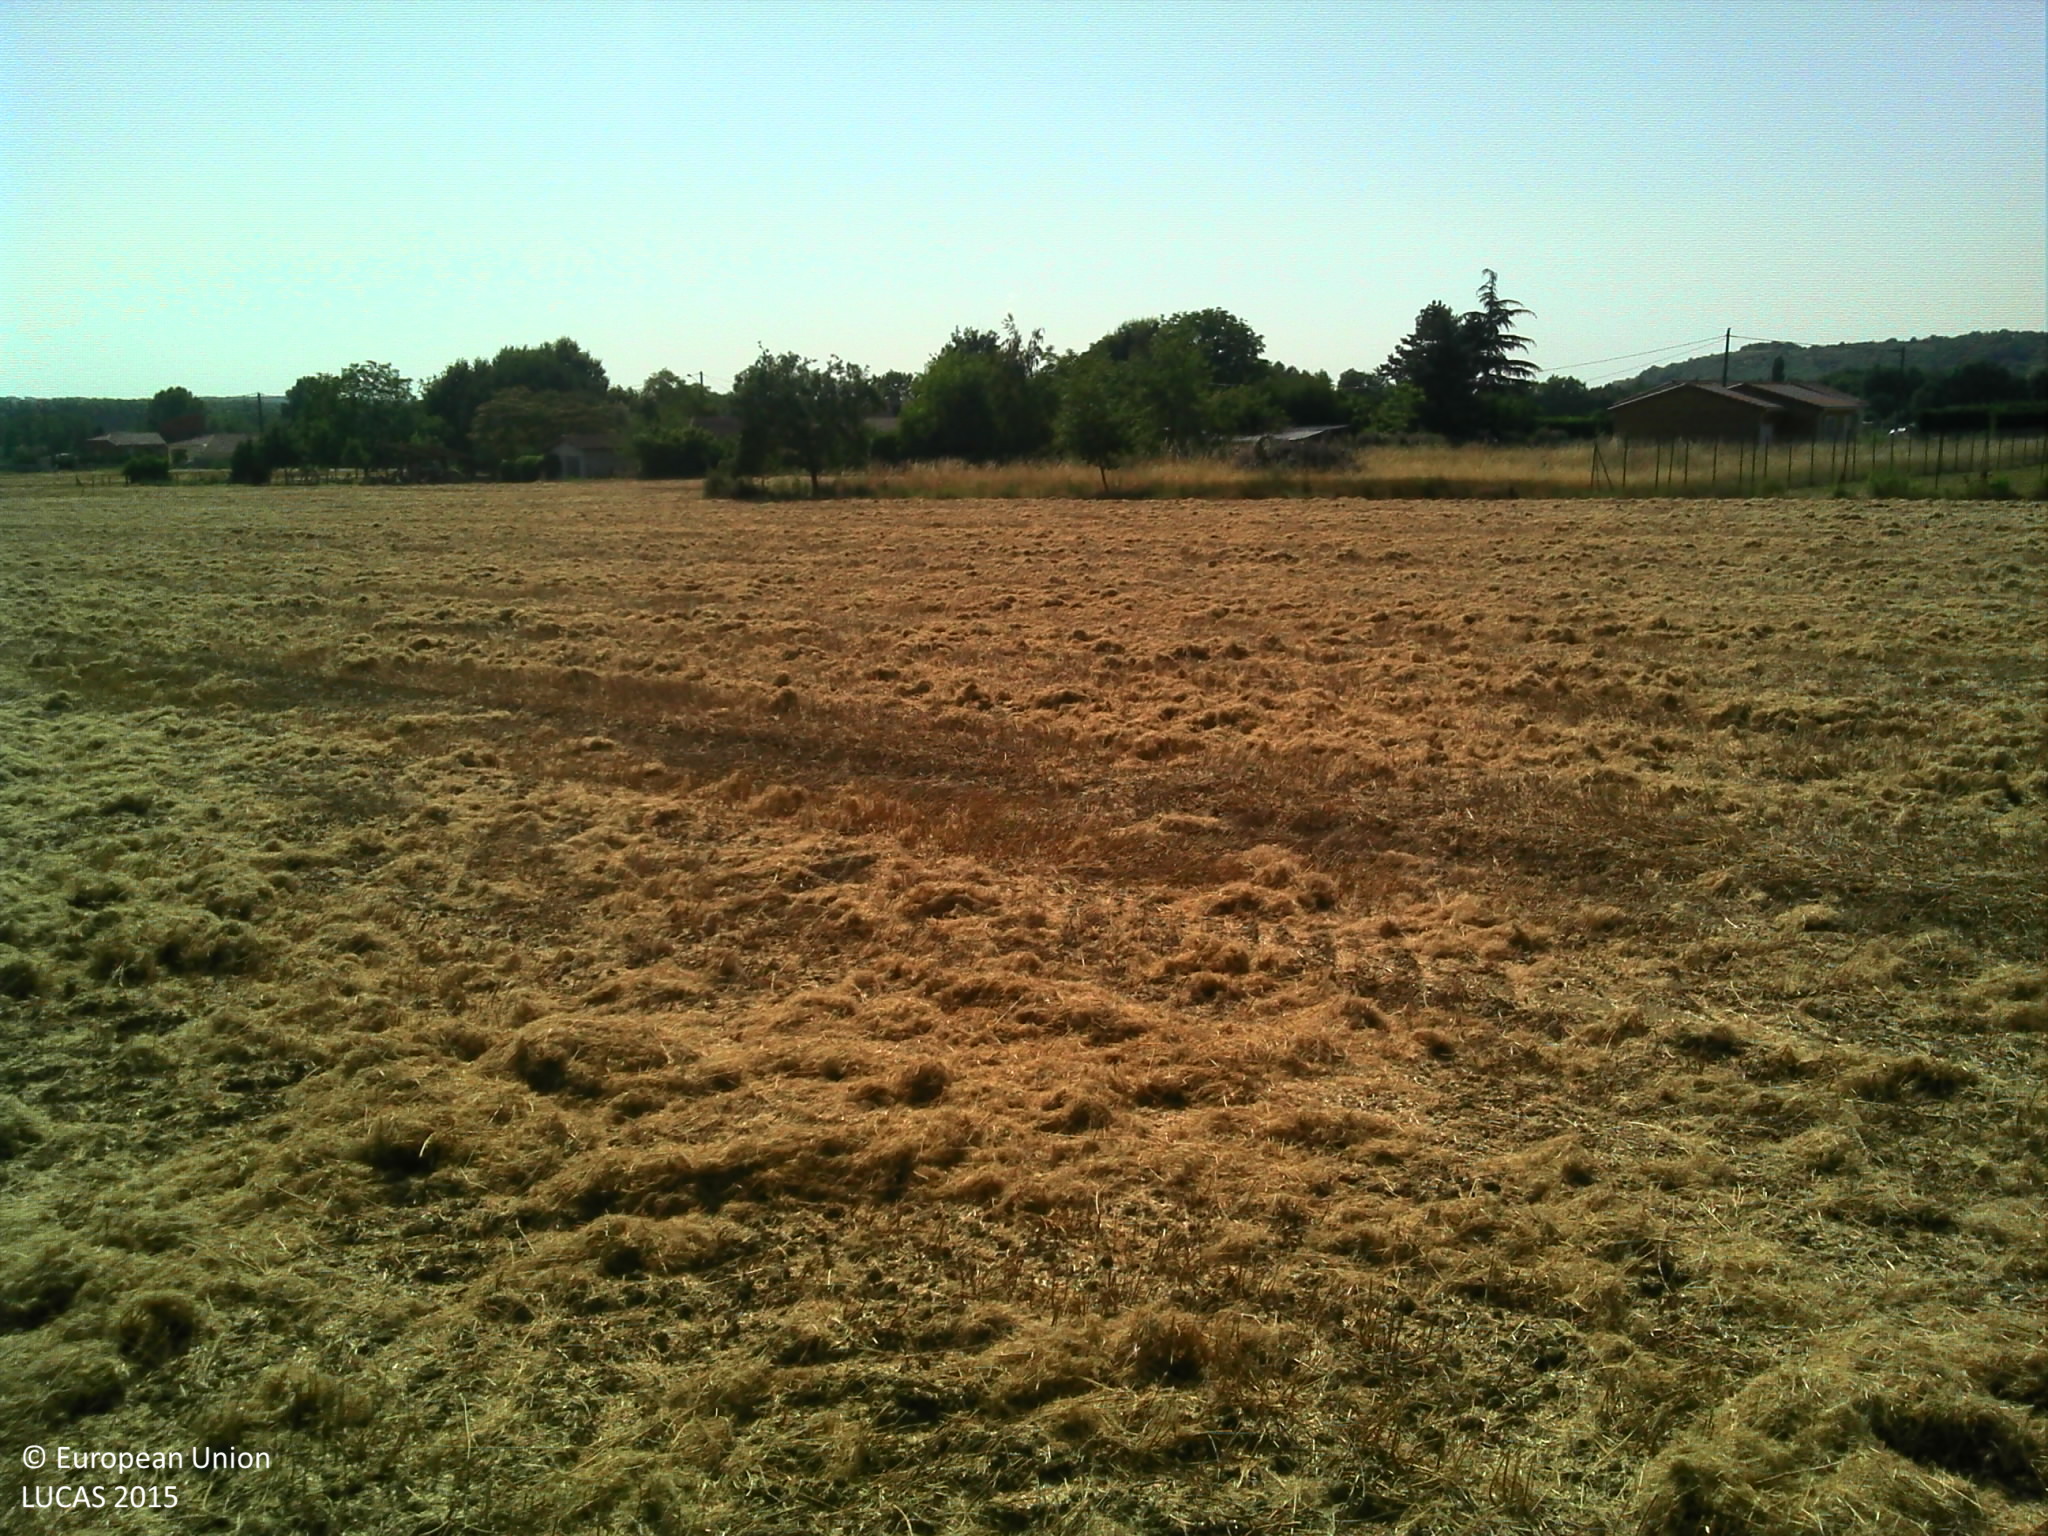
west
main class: Cropland
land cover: Common wheat
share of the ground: 50 - 75 %
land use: Agriculture (excluding fallow land and kitchen gardens)
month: July
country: FR
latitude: 44.1009
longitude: 0.9656
